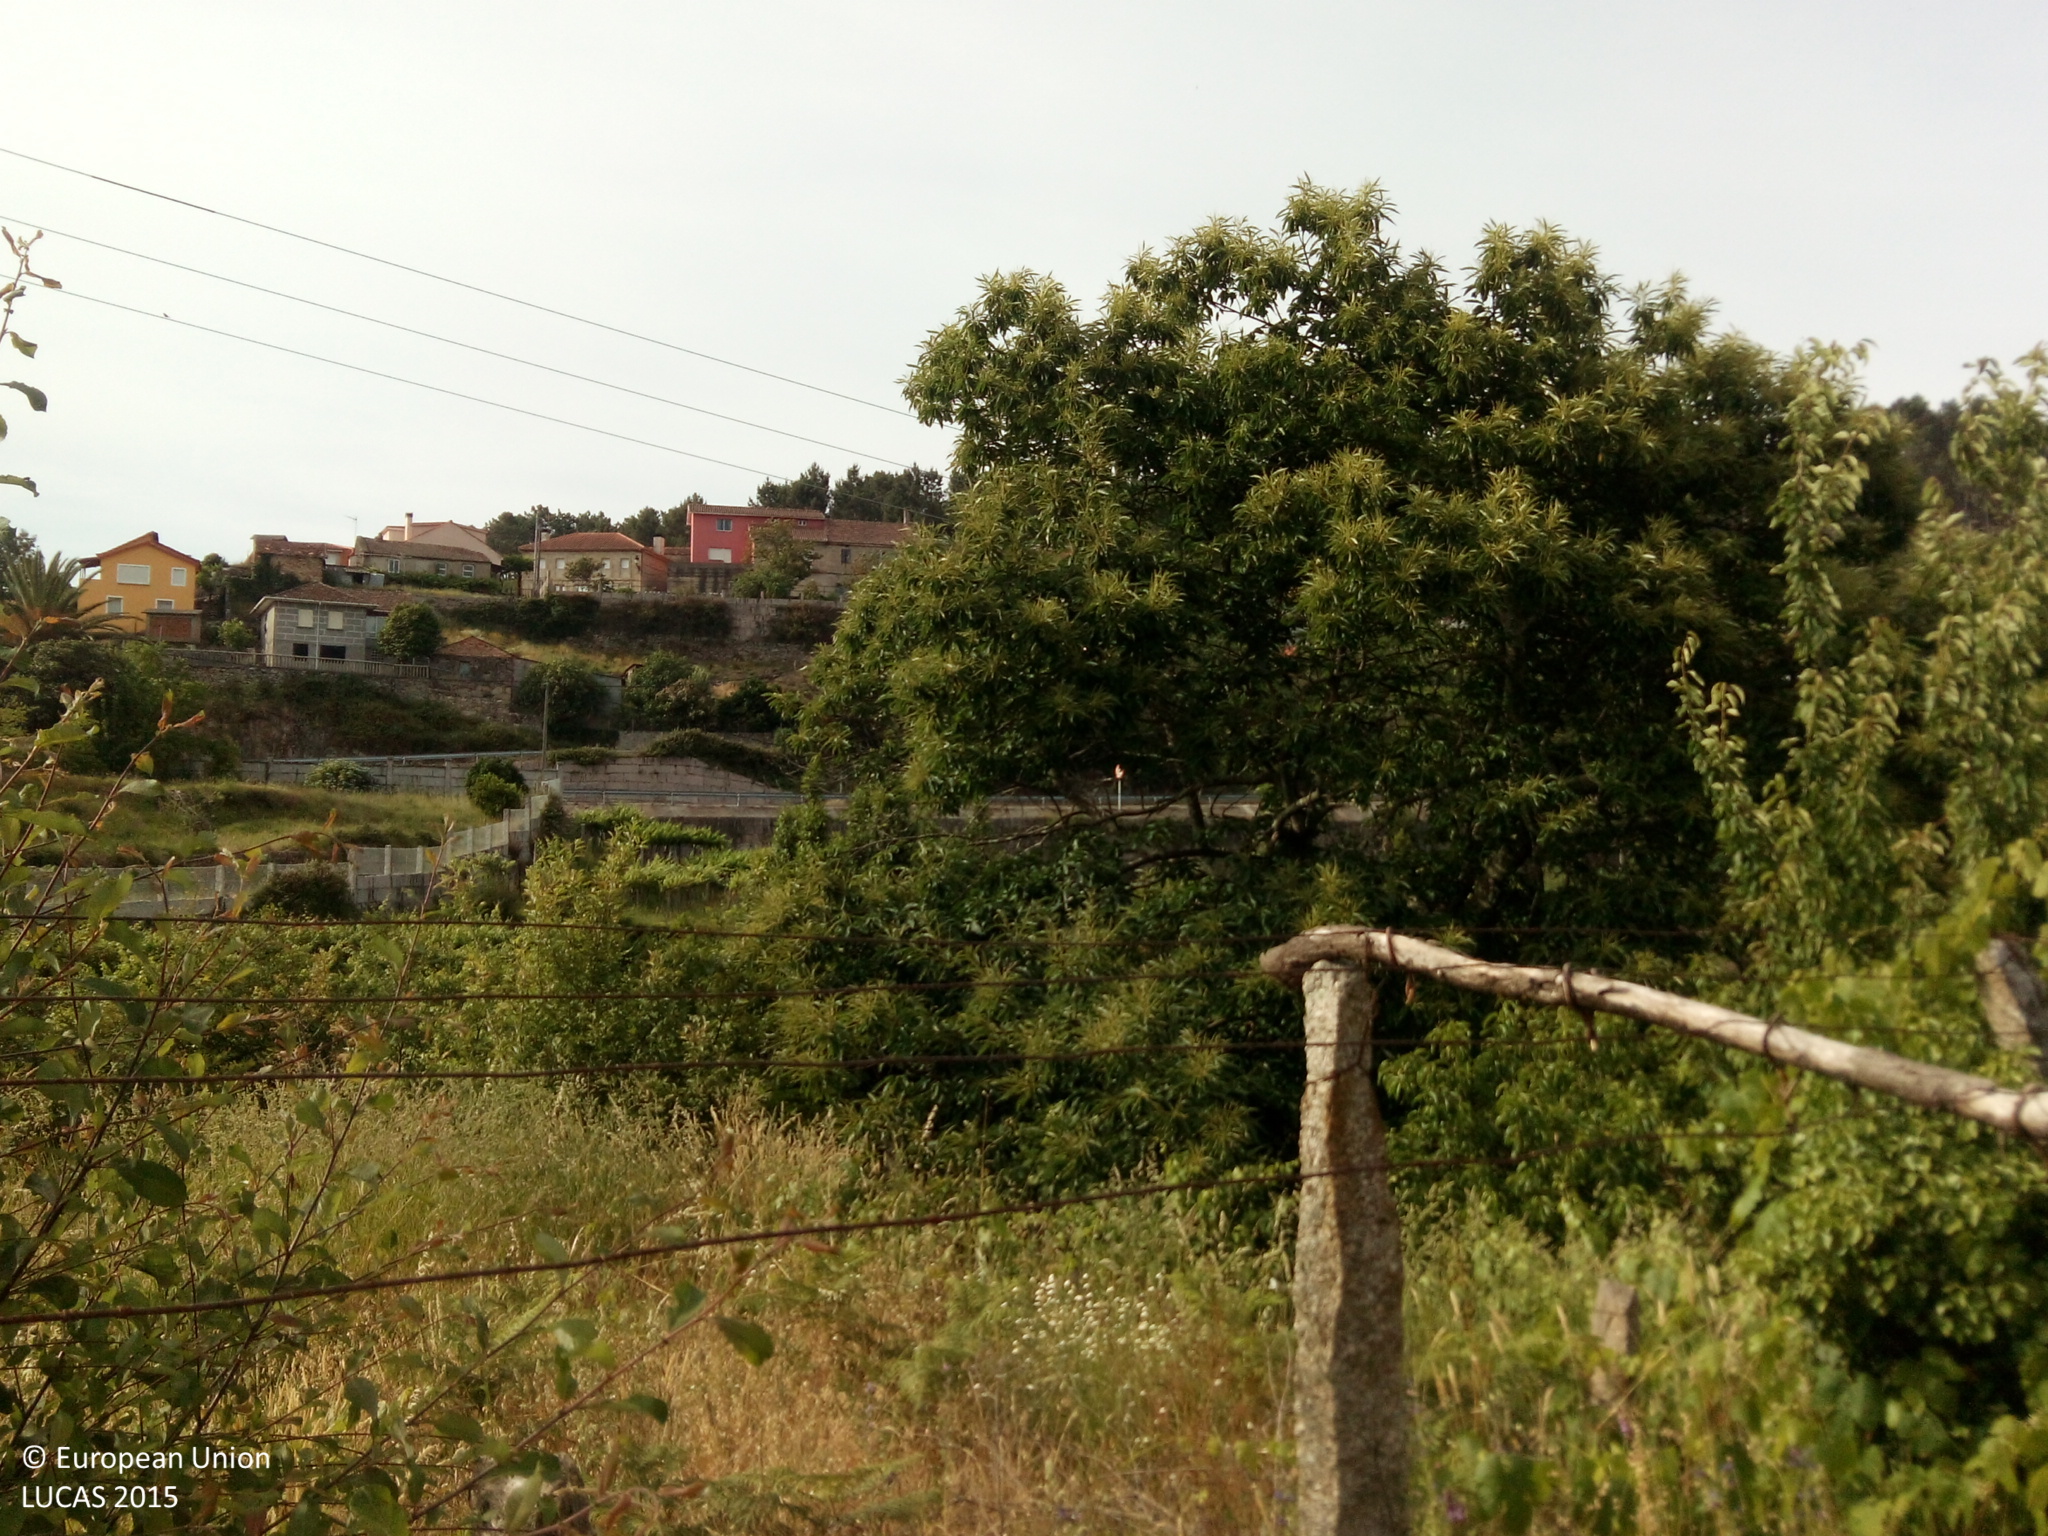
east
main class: Cropland
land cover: Vineyards
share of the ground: 50 - 75 %
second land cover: Grassland without tree/shrub cover
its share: 50 - 75 %
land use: Agriculture (excluding fallow land and kitchen gardens)
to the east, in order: Vineyards; Grassland without tree/shrub cover; Broadleaved woodland; Vineyards; Railways; Electric lines; Broadleaved woodland
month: June
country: ES
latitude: 42.1170
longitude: -8.2893
